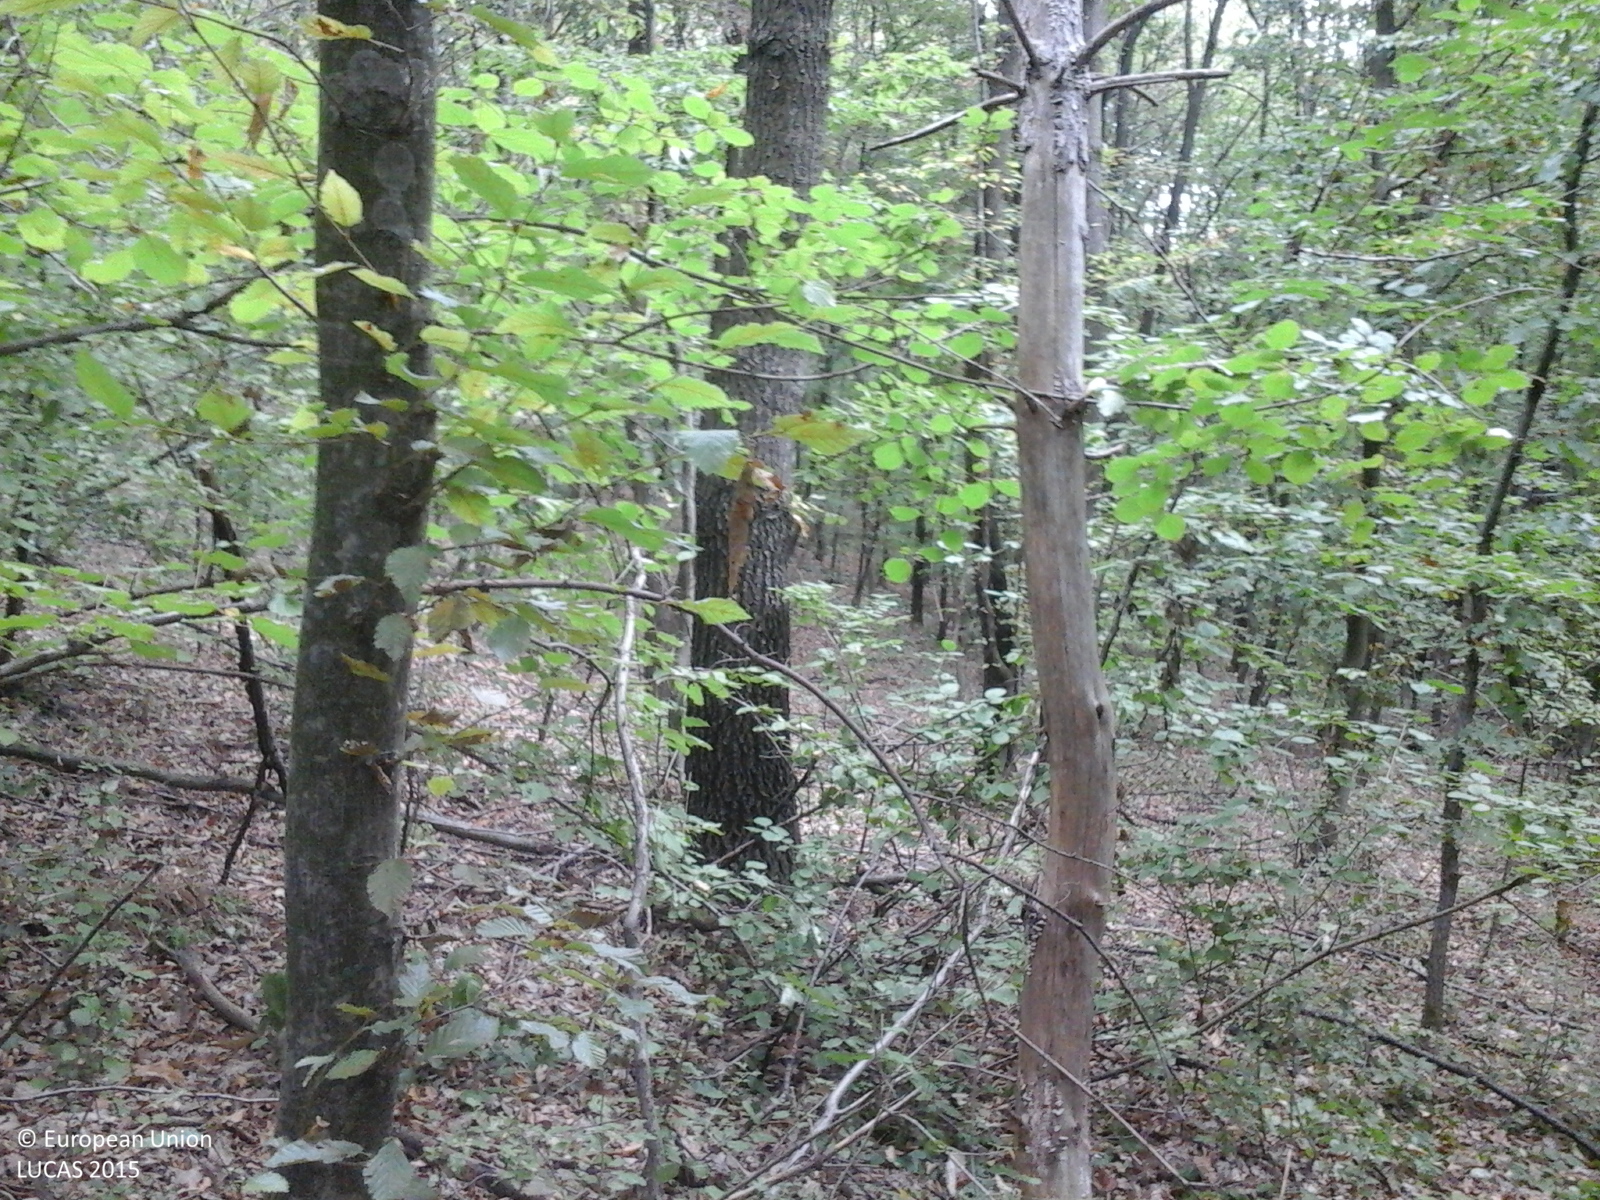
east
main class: Woodland
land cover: Broadleaved woodland
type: acidophilous oak and oak-birch forest
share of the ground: > 75 %
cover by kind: broadleaved forest trees 100 %
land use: Forestry
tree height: > 5 m
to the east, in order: Broadleaved woodland; Spontaneously vegetated surfaces; Grassland with sparse tree/shrub cover
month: September
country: RO
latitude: 47.2336
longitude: 23.1292
